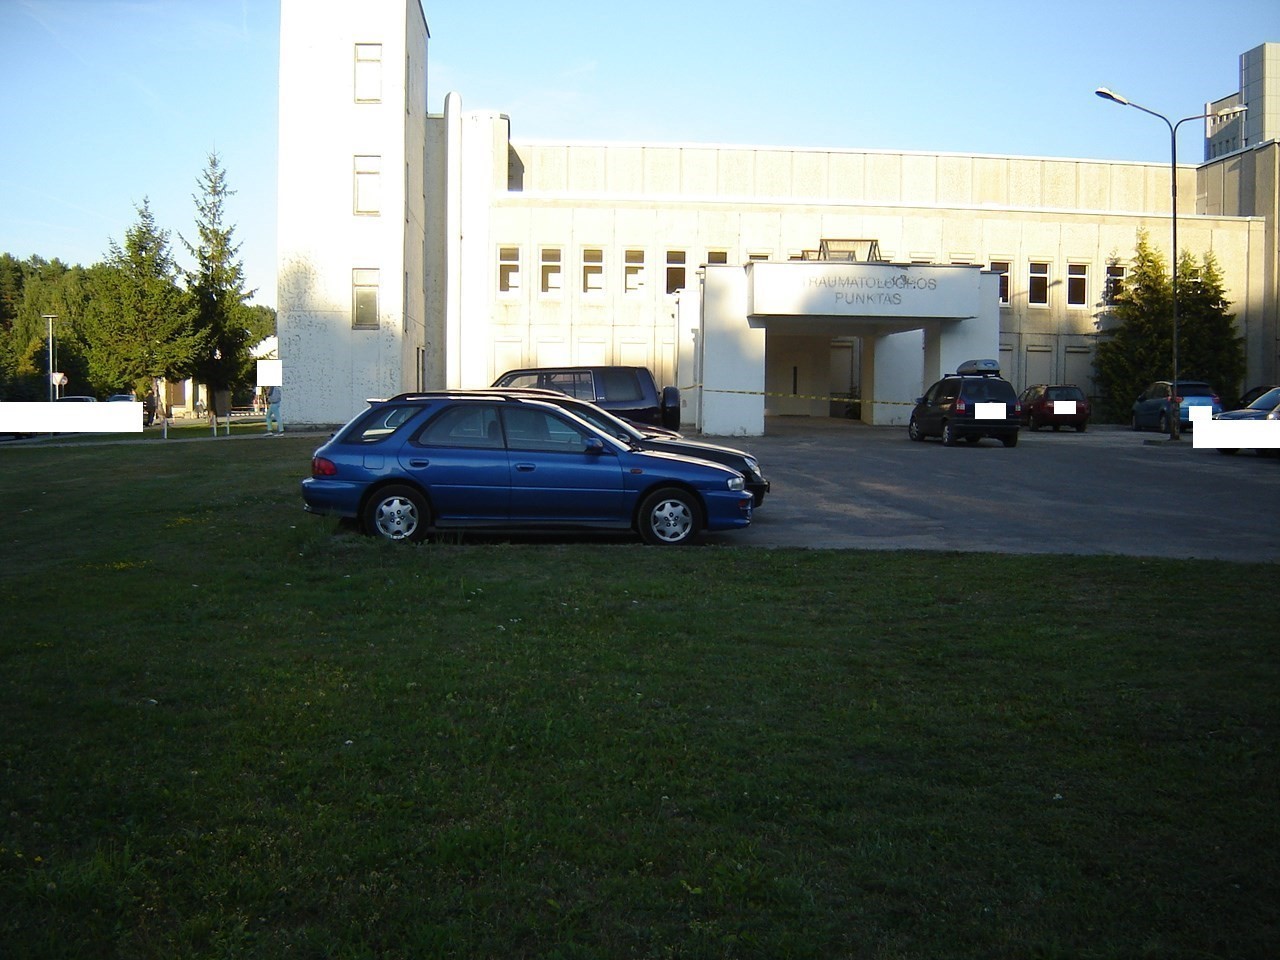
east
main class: Grassland
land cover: Grassland without tree/shrub cover
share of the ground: > 75 %
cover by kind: herbaceous plants 100 %
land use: Community services
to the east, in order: Grassland without tree/shrub cover; Artificial constructions in urban areas
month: August
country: LT
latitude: 54.6688
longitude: 25.2062
